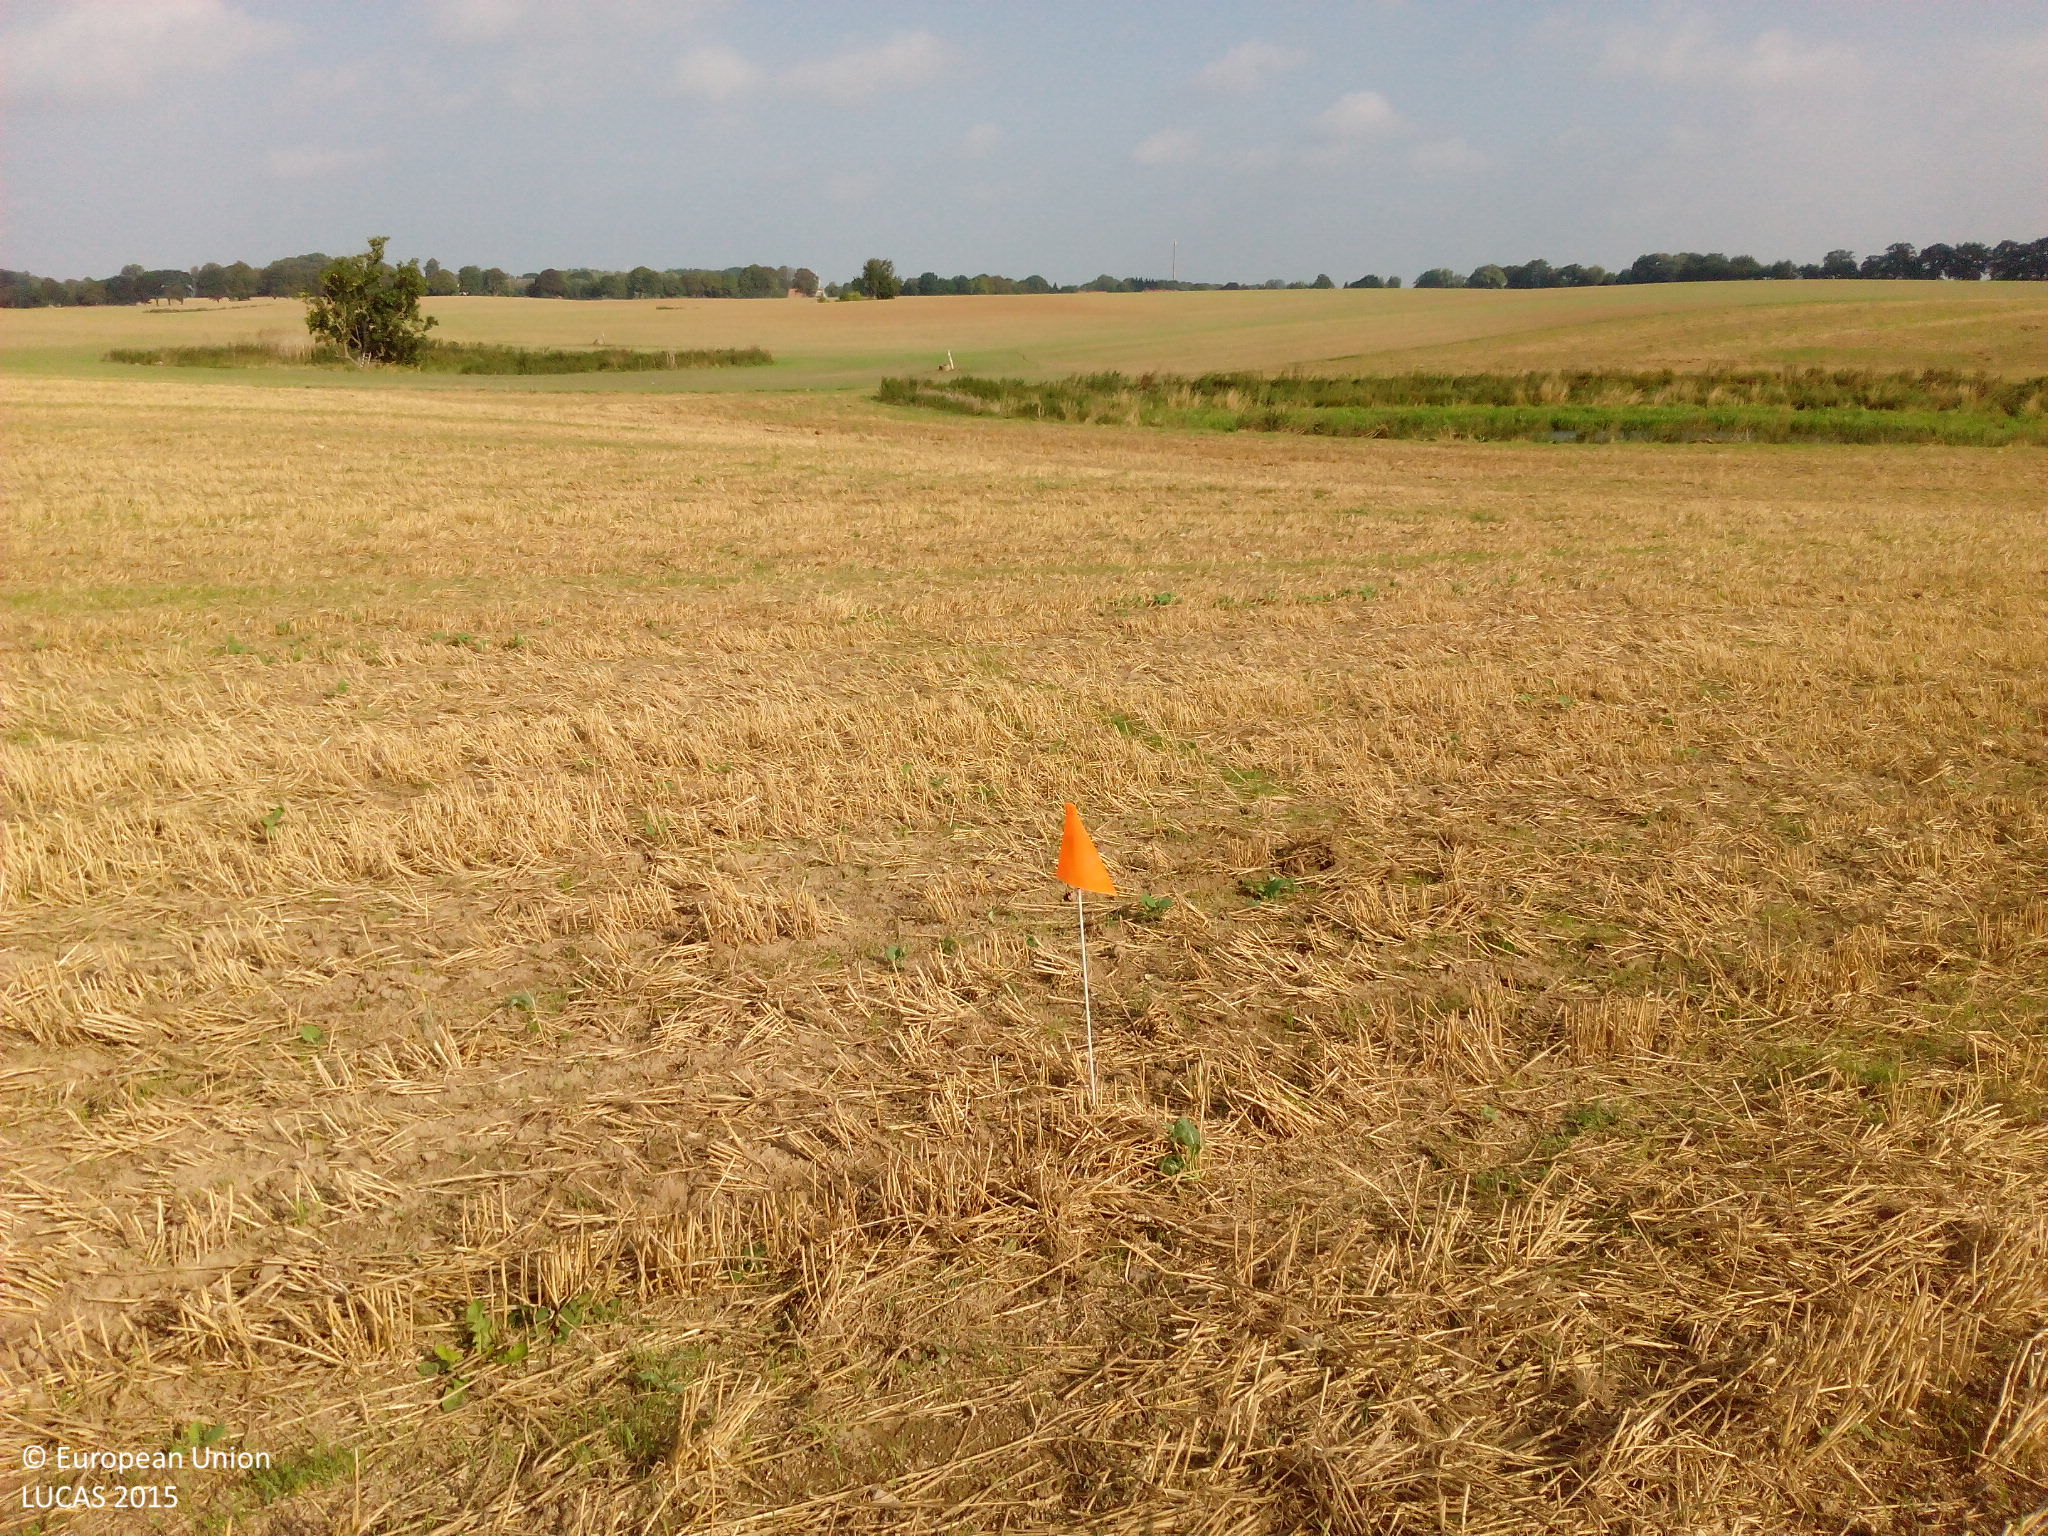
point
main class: Cropland
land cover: Common wheat
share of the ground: 50 - 75 %
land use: Agriculture (excluding fallow land and kitchen gardens)
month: September
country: DE
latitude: 54.1270
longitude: 12.7076
